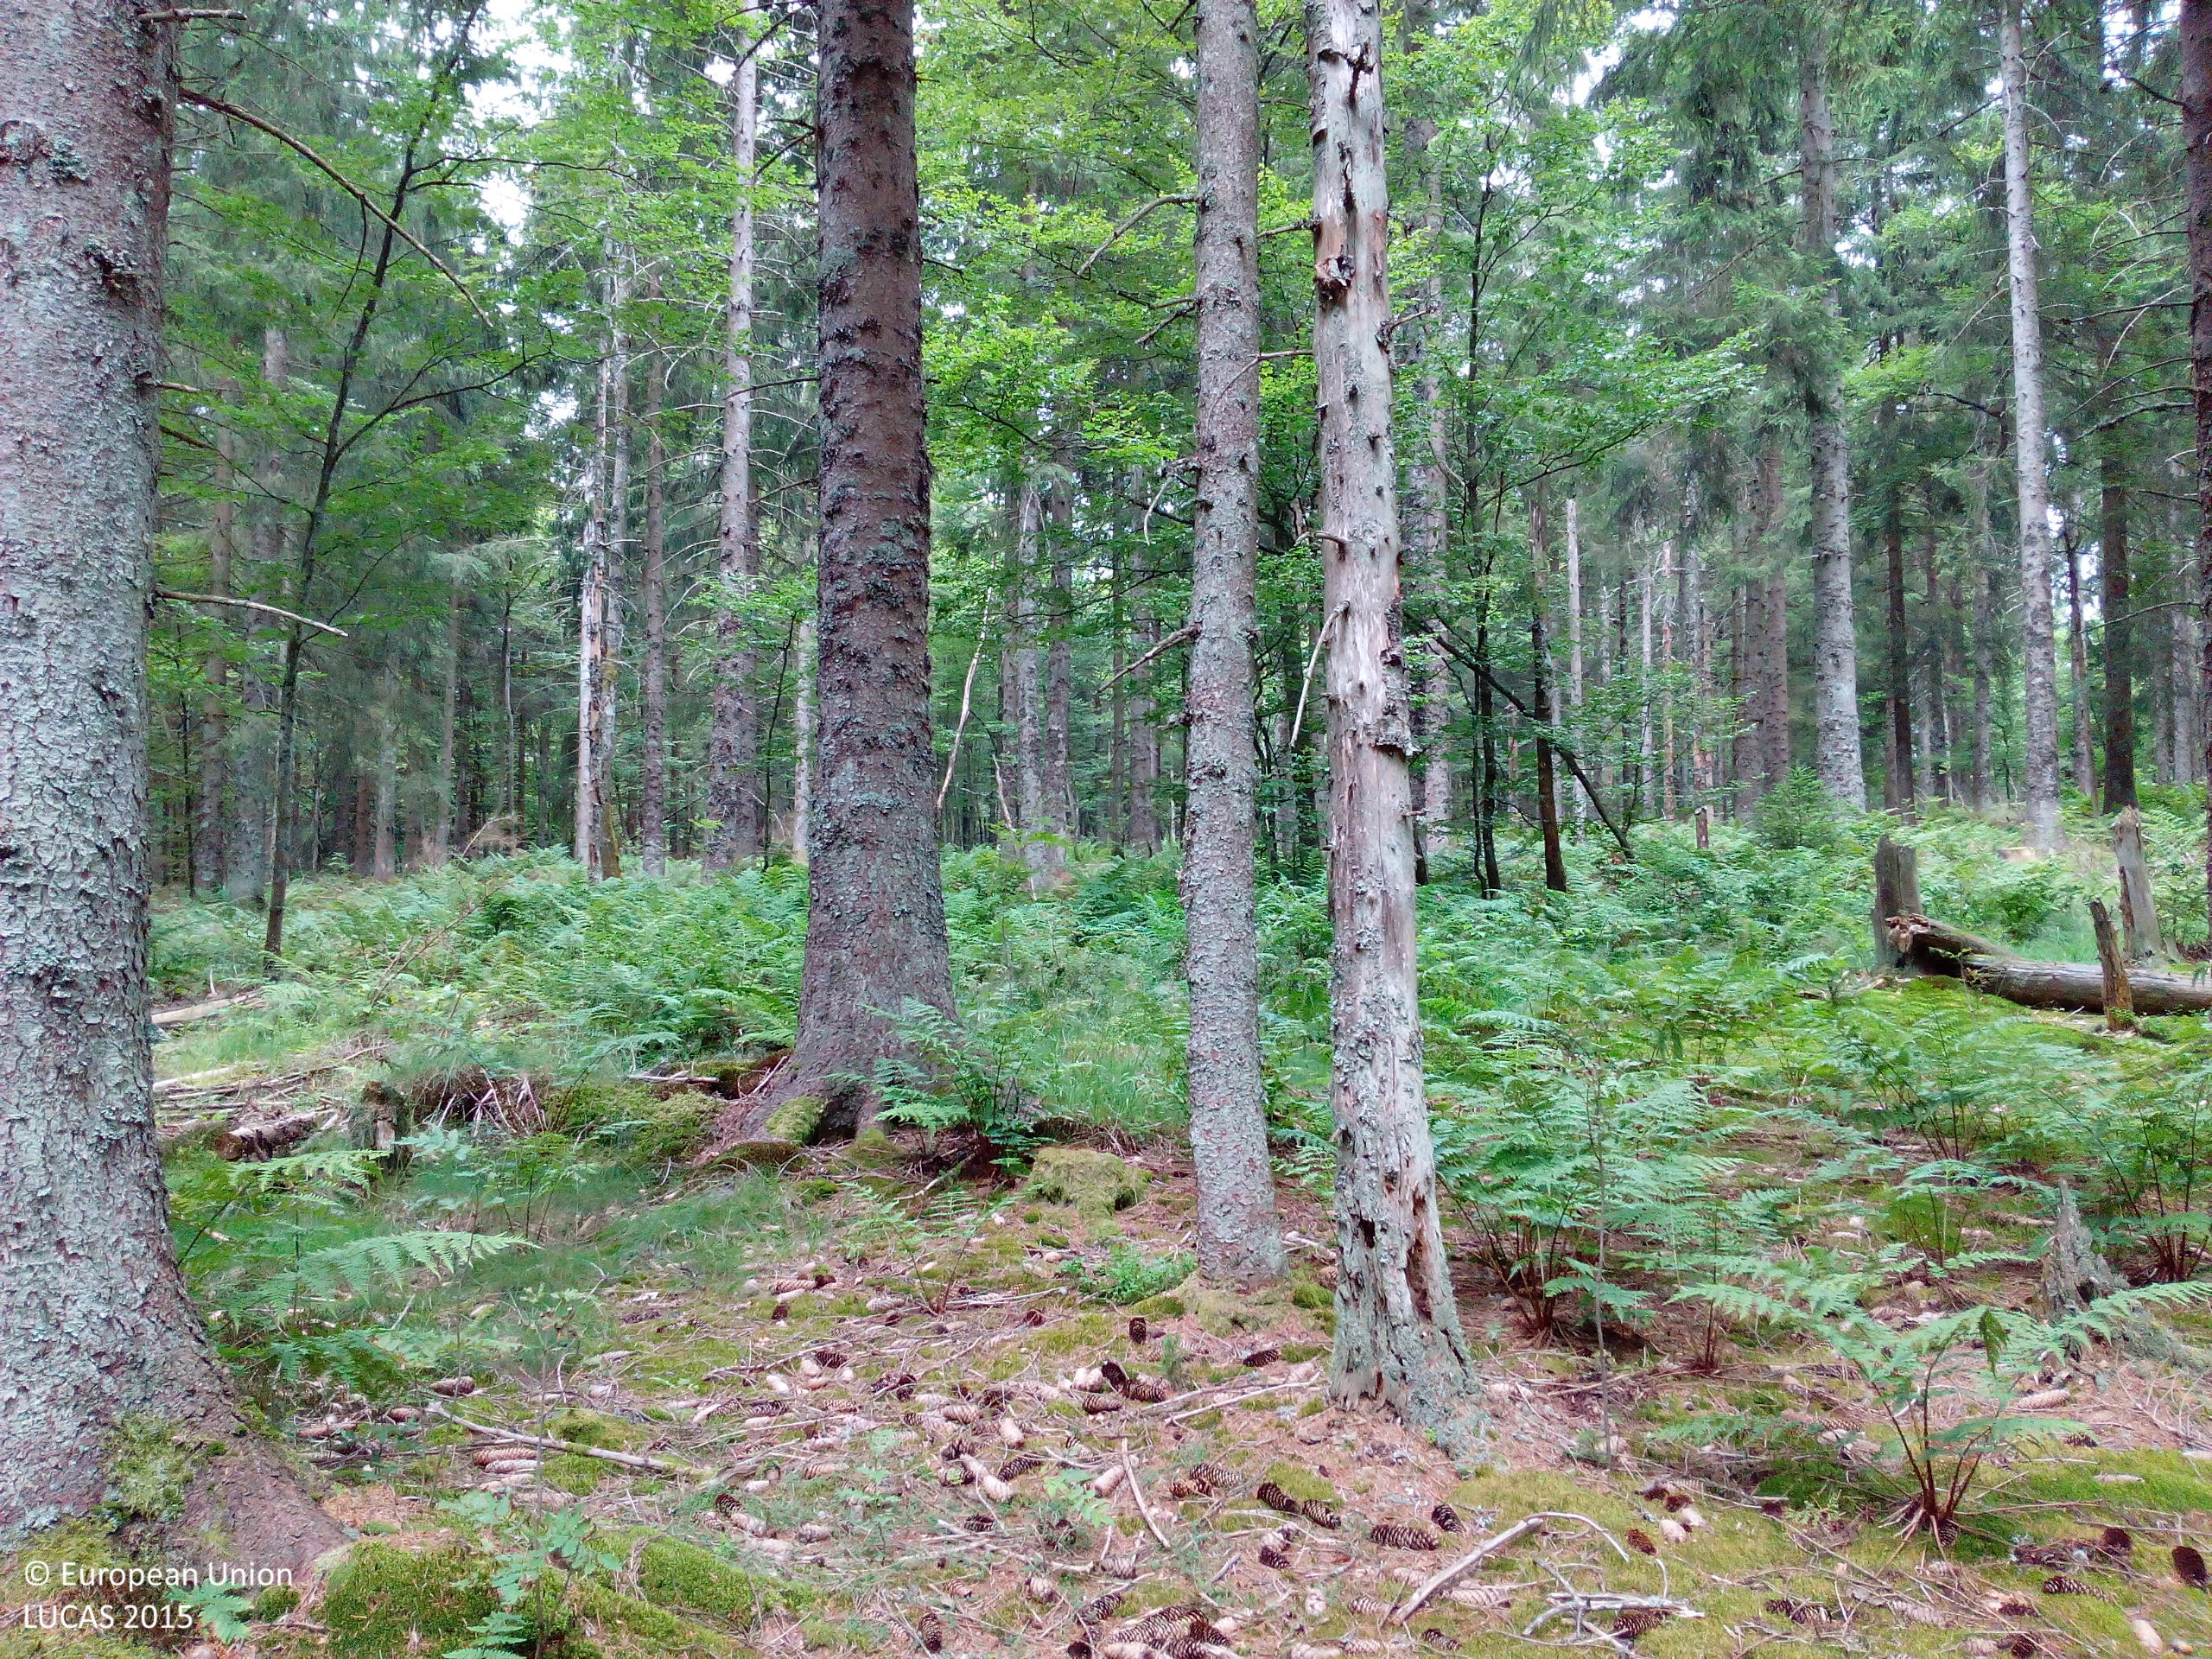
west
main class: Woodland
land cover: Spruce dominated coniferous woodland
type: hemiboreal forest and nemoral coniferous forest and mixed broadleaved-coniferous forest
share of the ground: 50 - 75 %
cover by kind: coniferous forest trees 65 %, herbaceous plants 15 %, lichens and mosses 10 %, broadleaved forest trees 5 %, shrubs 5 %
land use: Forestry
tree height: > 5 m
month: August
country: DE
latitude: 48.1178
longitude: 8.1338
